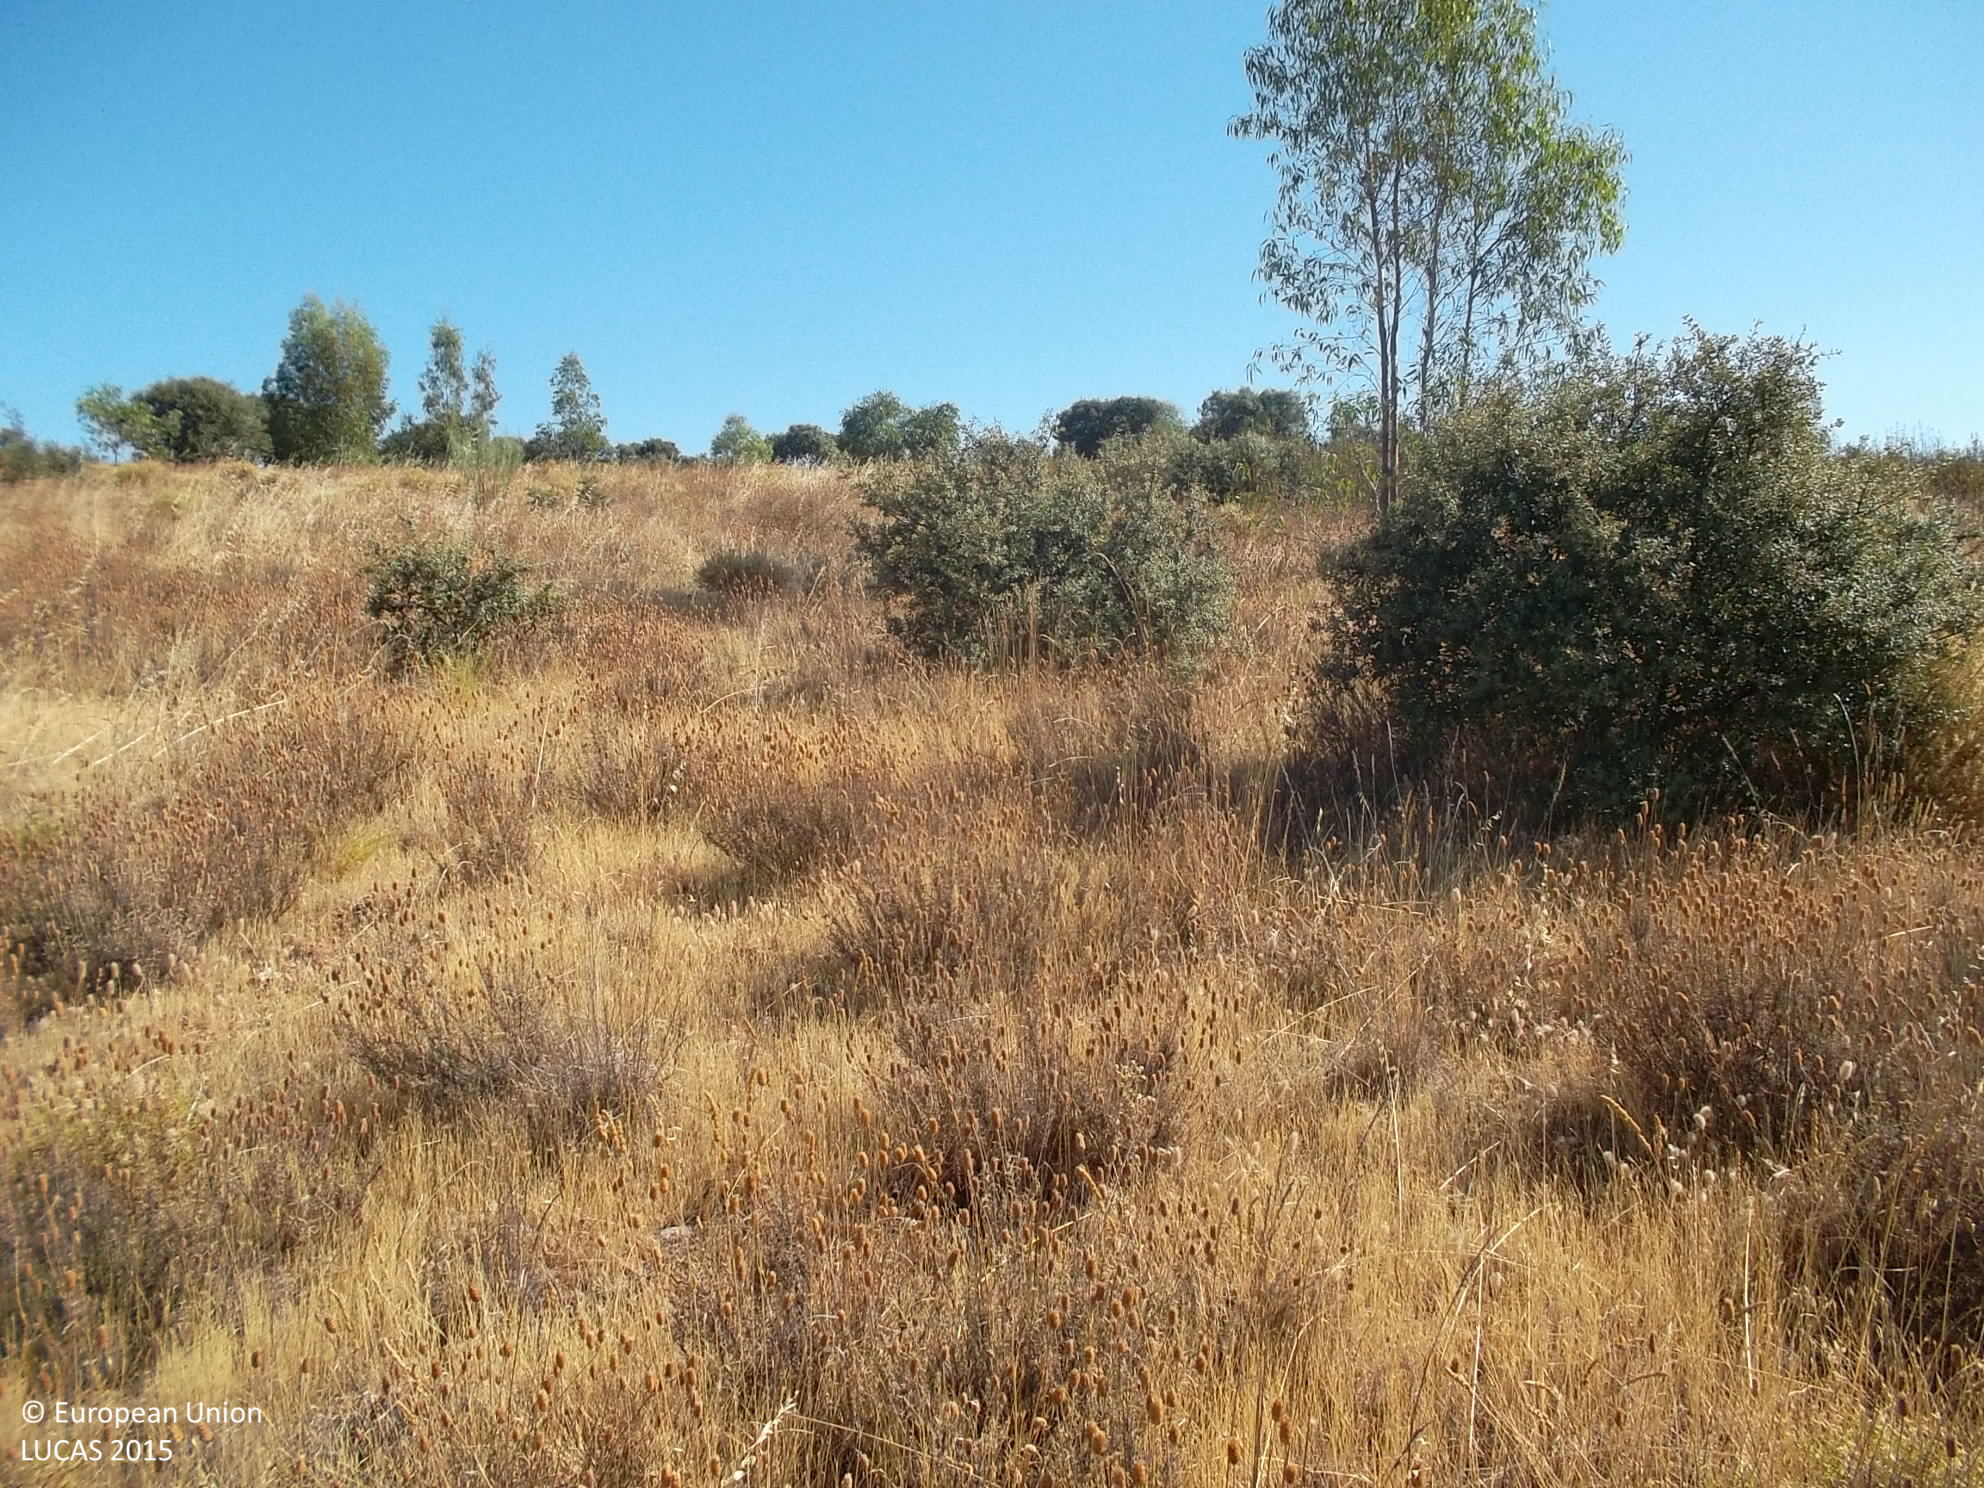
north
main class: Shrubland
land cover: Shrubland with sparse tree cover
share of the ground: > 75 %
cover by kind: shrubs 50 %, herbaceous plants 45 %, broadleaved forest trees 5 %
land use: Semi-natural and natural areas not in use
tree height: < 5 m
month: July
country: ES
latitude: 38.4769
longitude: -5.8247
